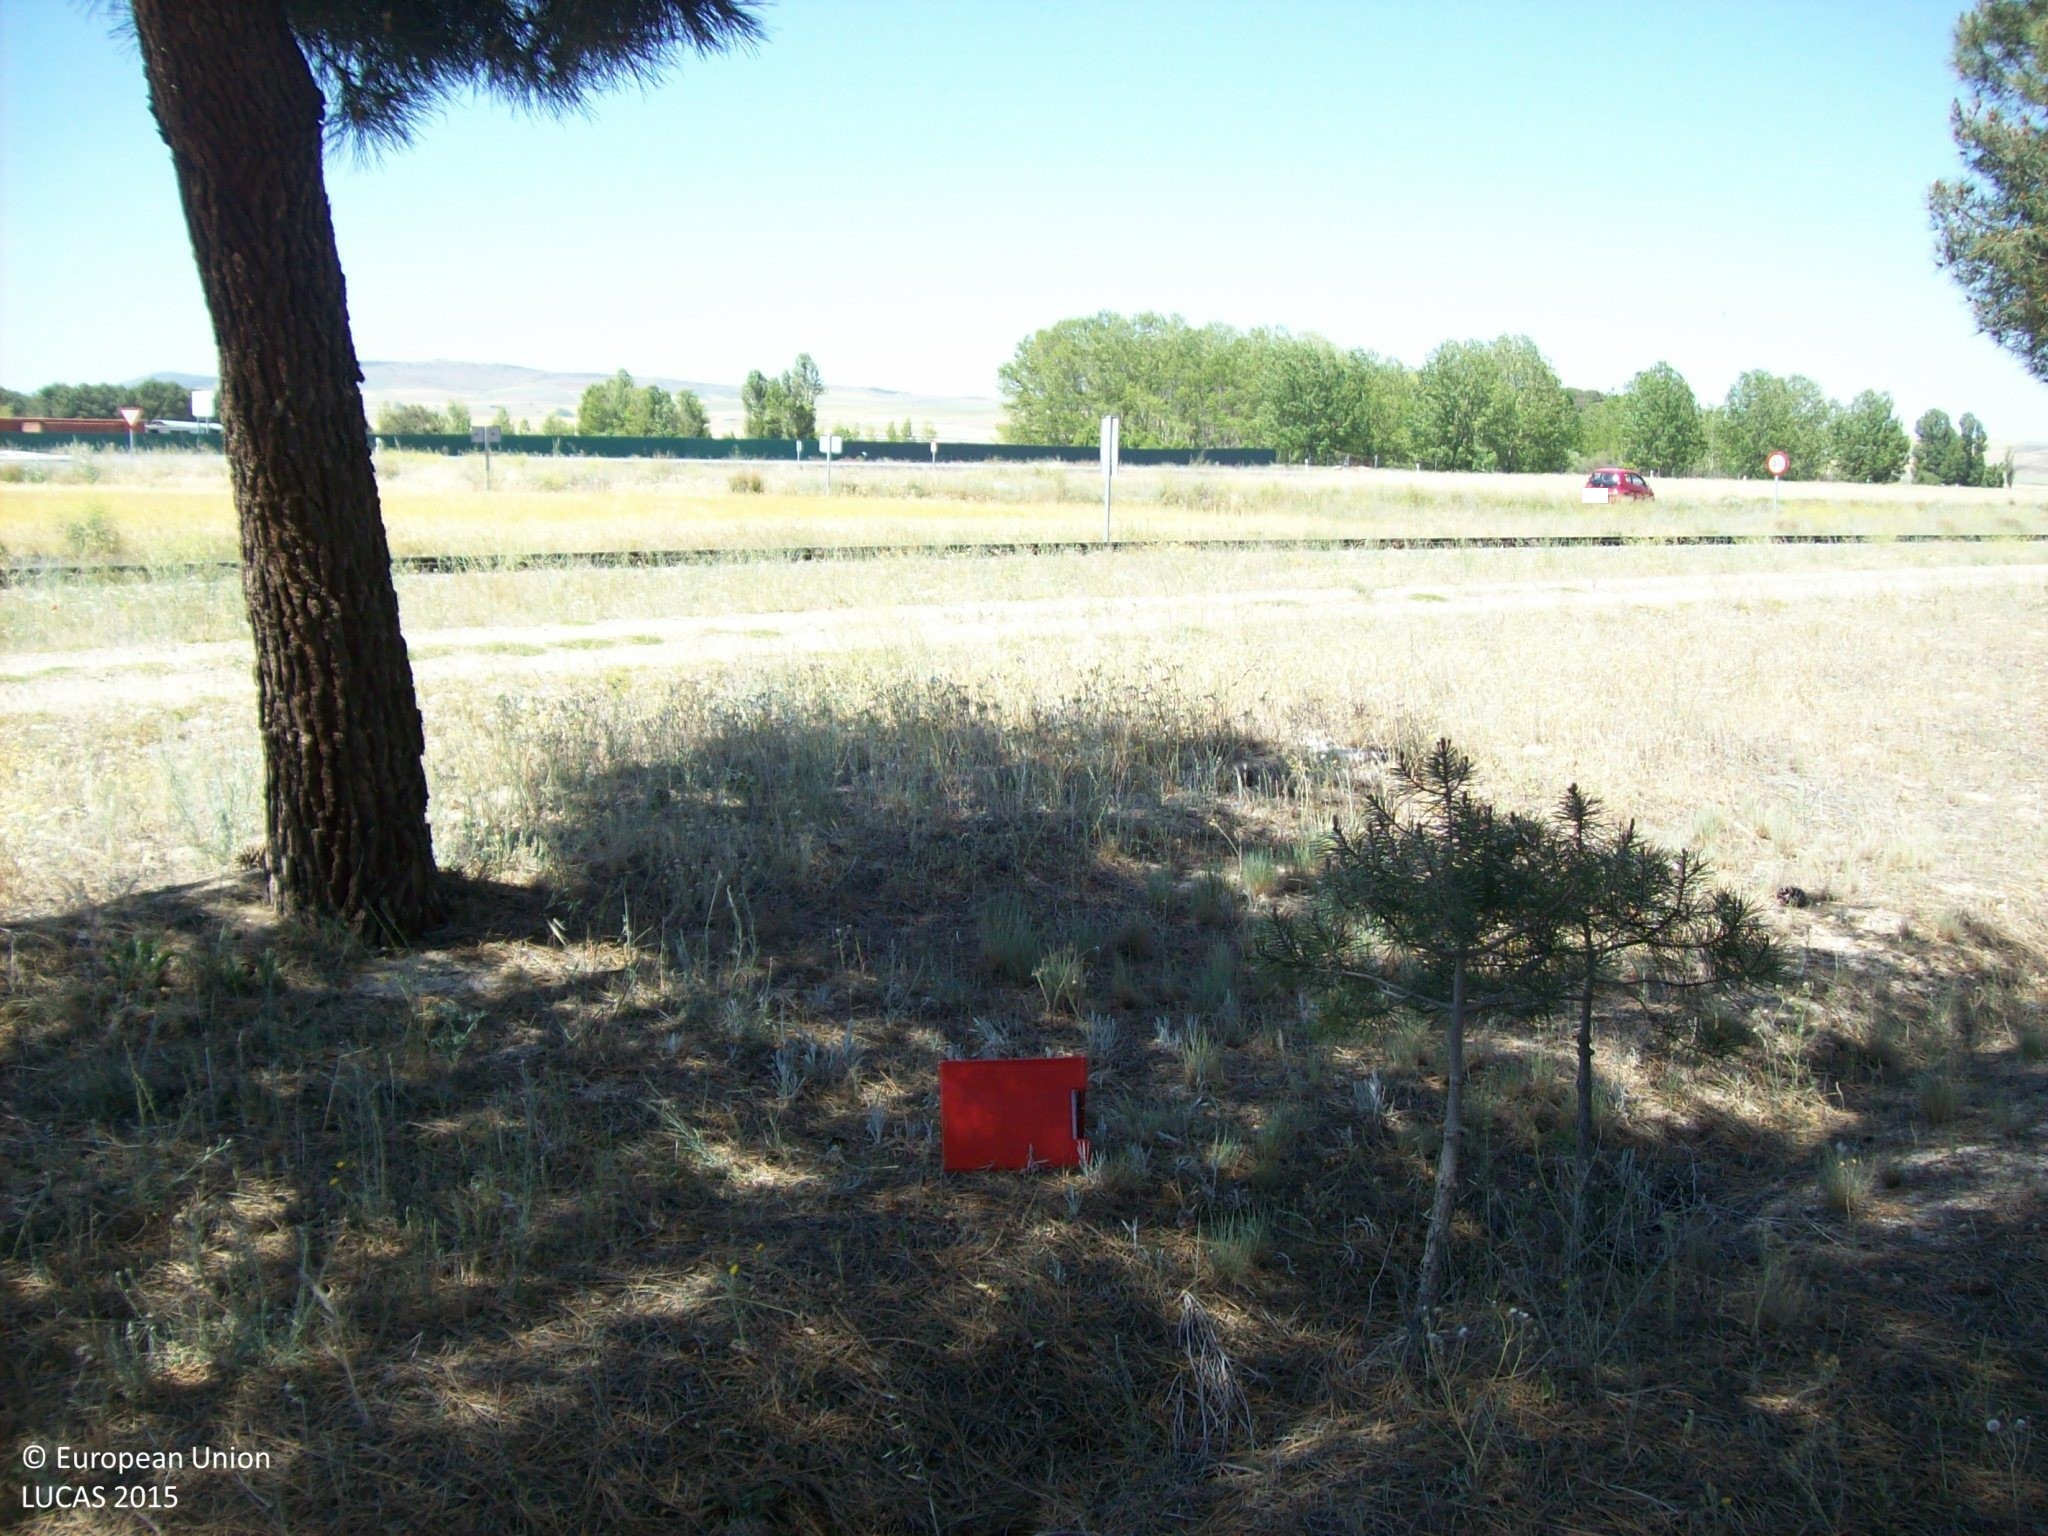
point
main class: Woodland
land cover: Pine dominated coniferous woodland
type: coniferous forest of the mediterranean region
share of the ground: 25 - 50 %
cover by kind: unconsolidated bare surface 50 %, coniferous forest trees 30 %, herbaceous plants 10 %
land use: Forestry
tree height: < 5 m
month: May
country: ES
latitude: 40.8125
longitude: -4.8915
